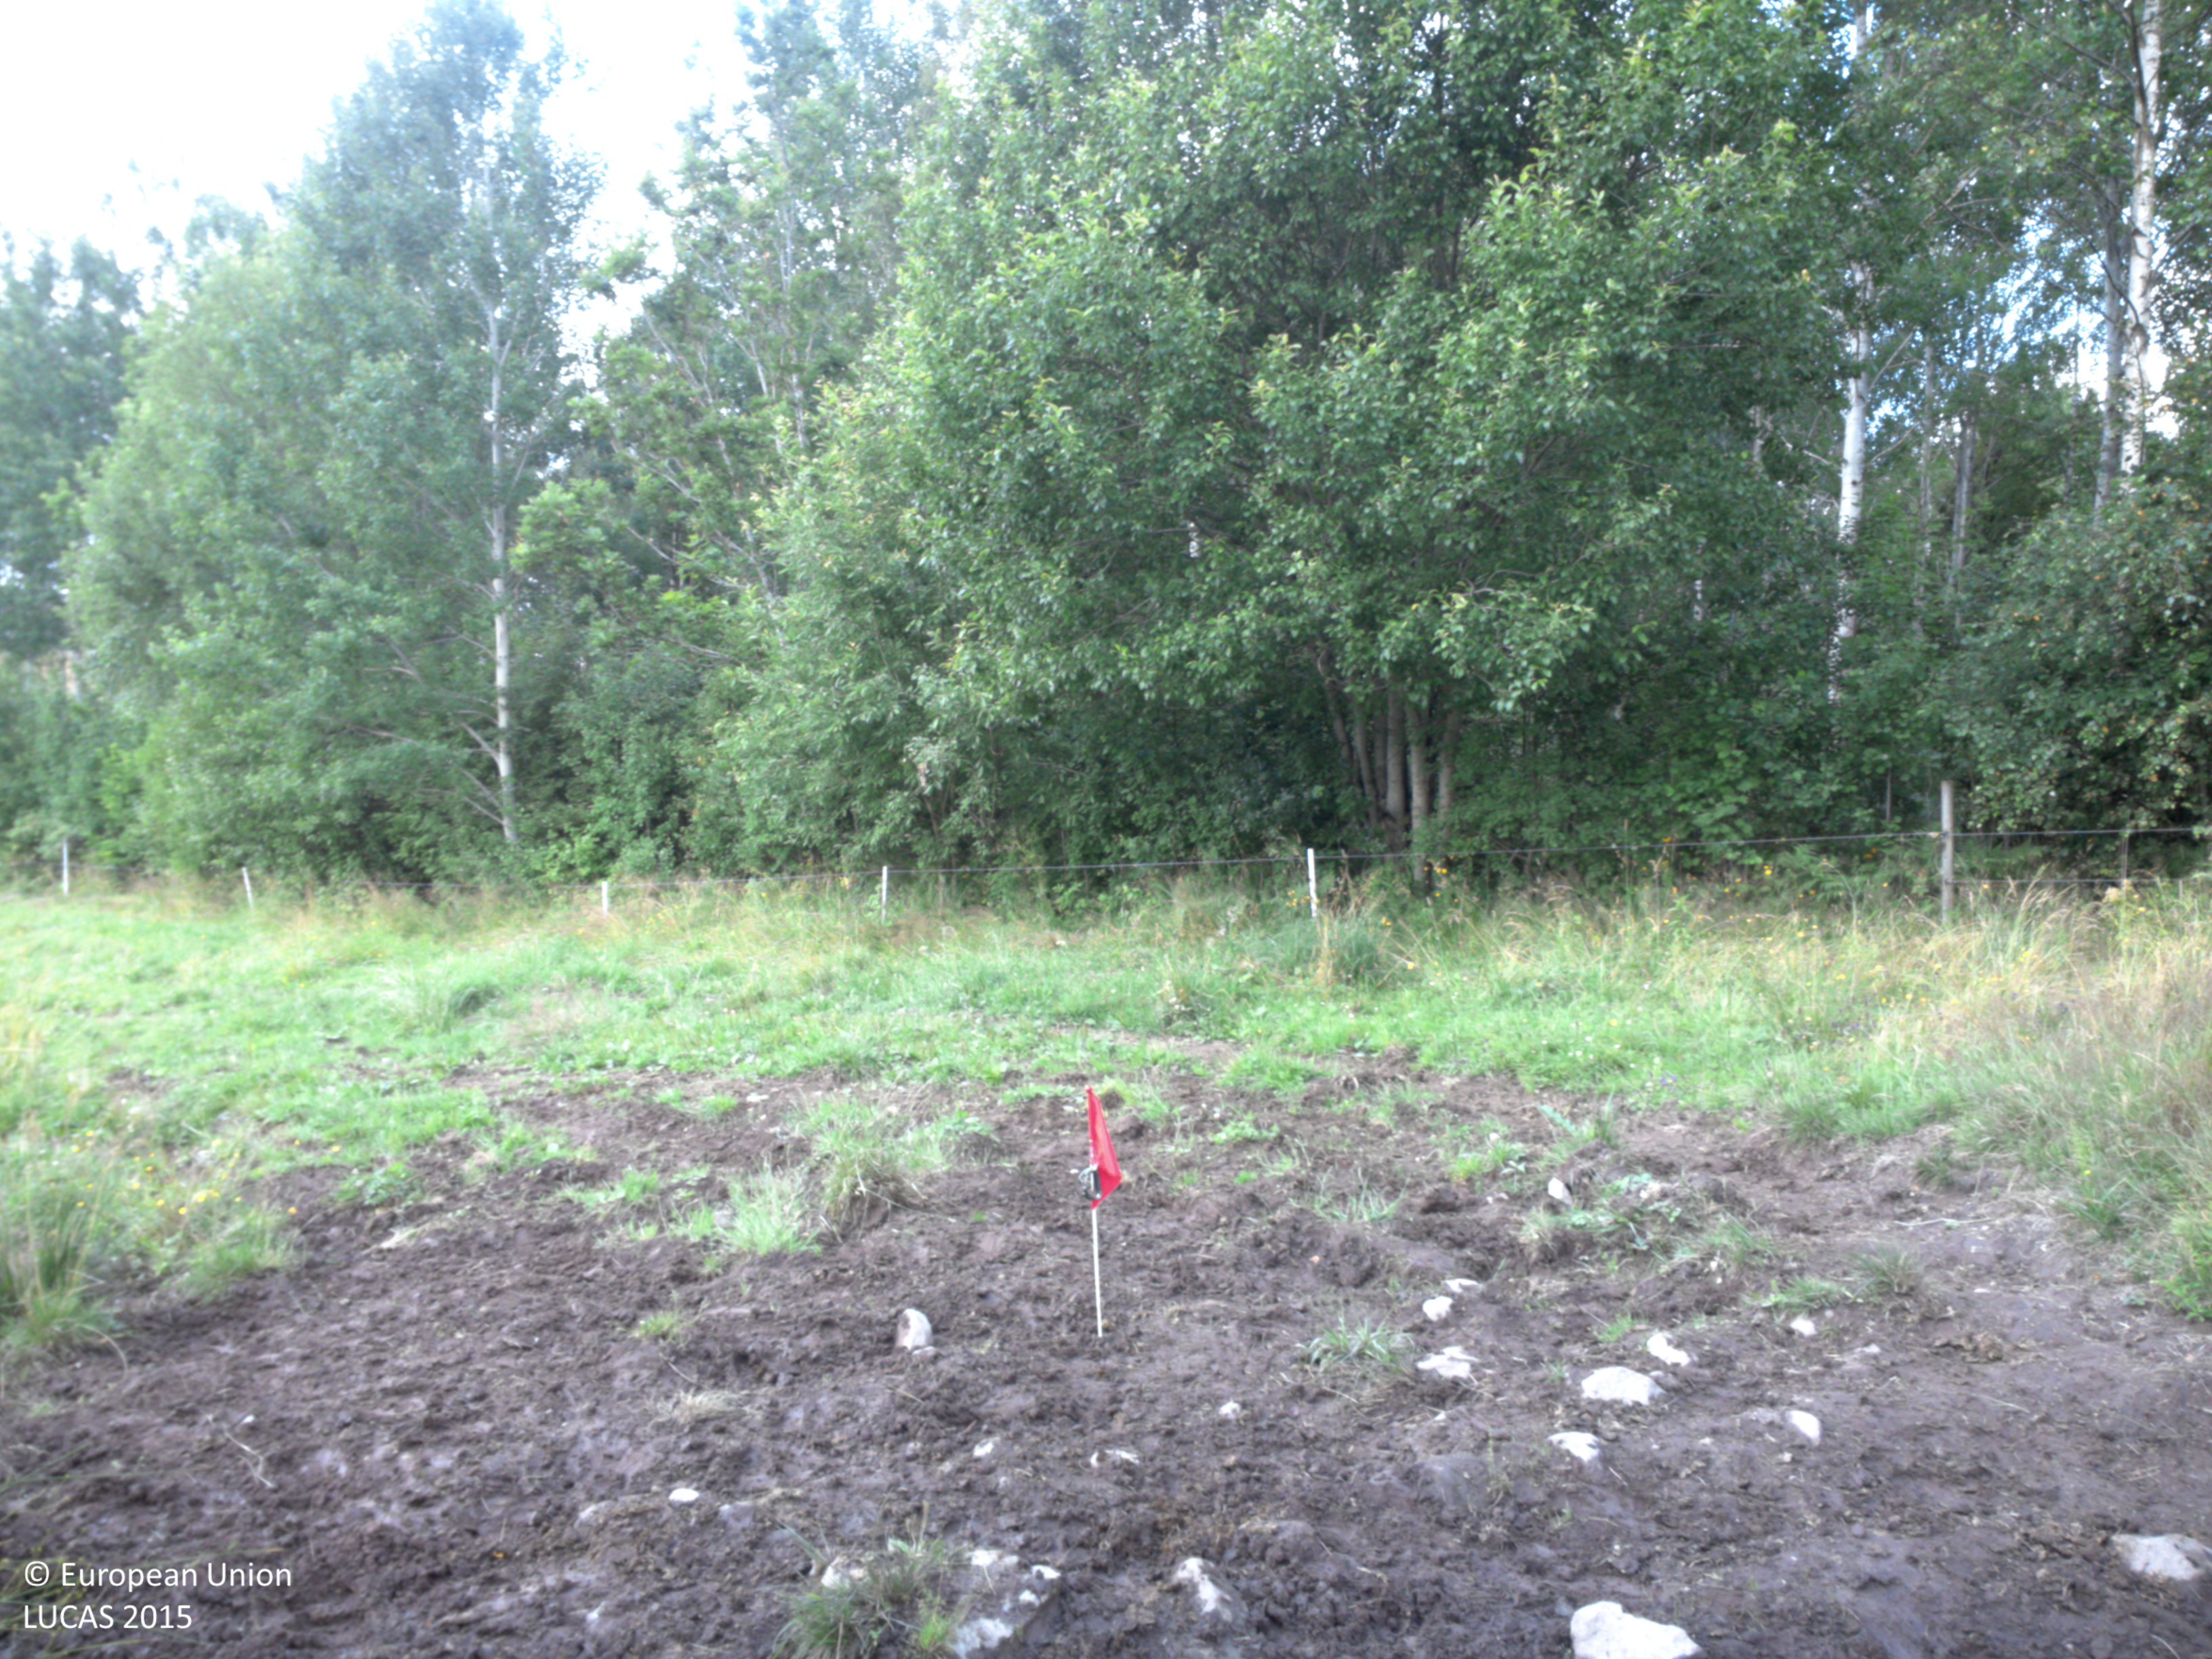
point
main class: Grassland
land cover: Grassland without tree/shrub cover
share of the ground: > 75 %
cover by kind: herbaceous plants 80 %, unconsolidated bare surface 20 %
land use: Agriculture (excluding fallow land and kitchen gardens)
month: July
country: SE
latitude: 58.6392
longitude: 11.8050
